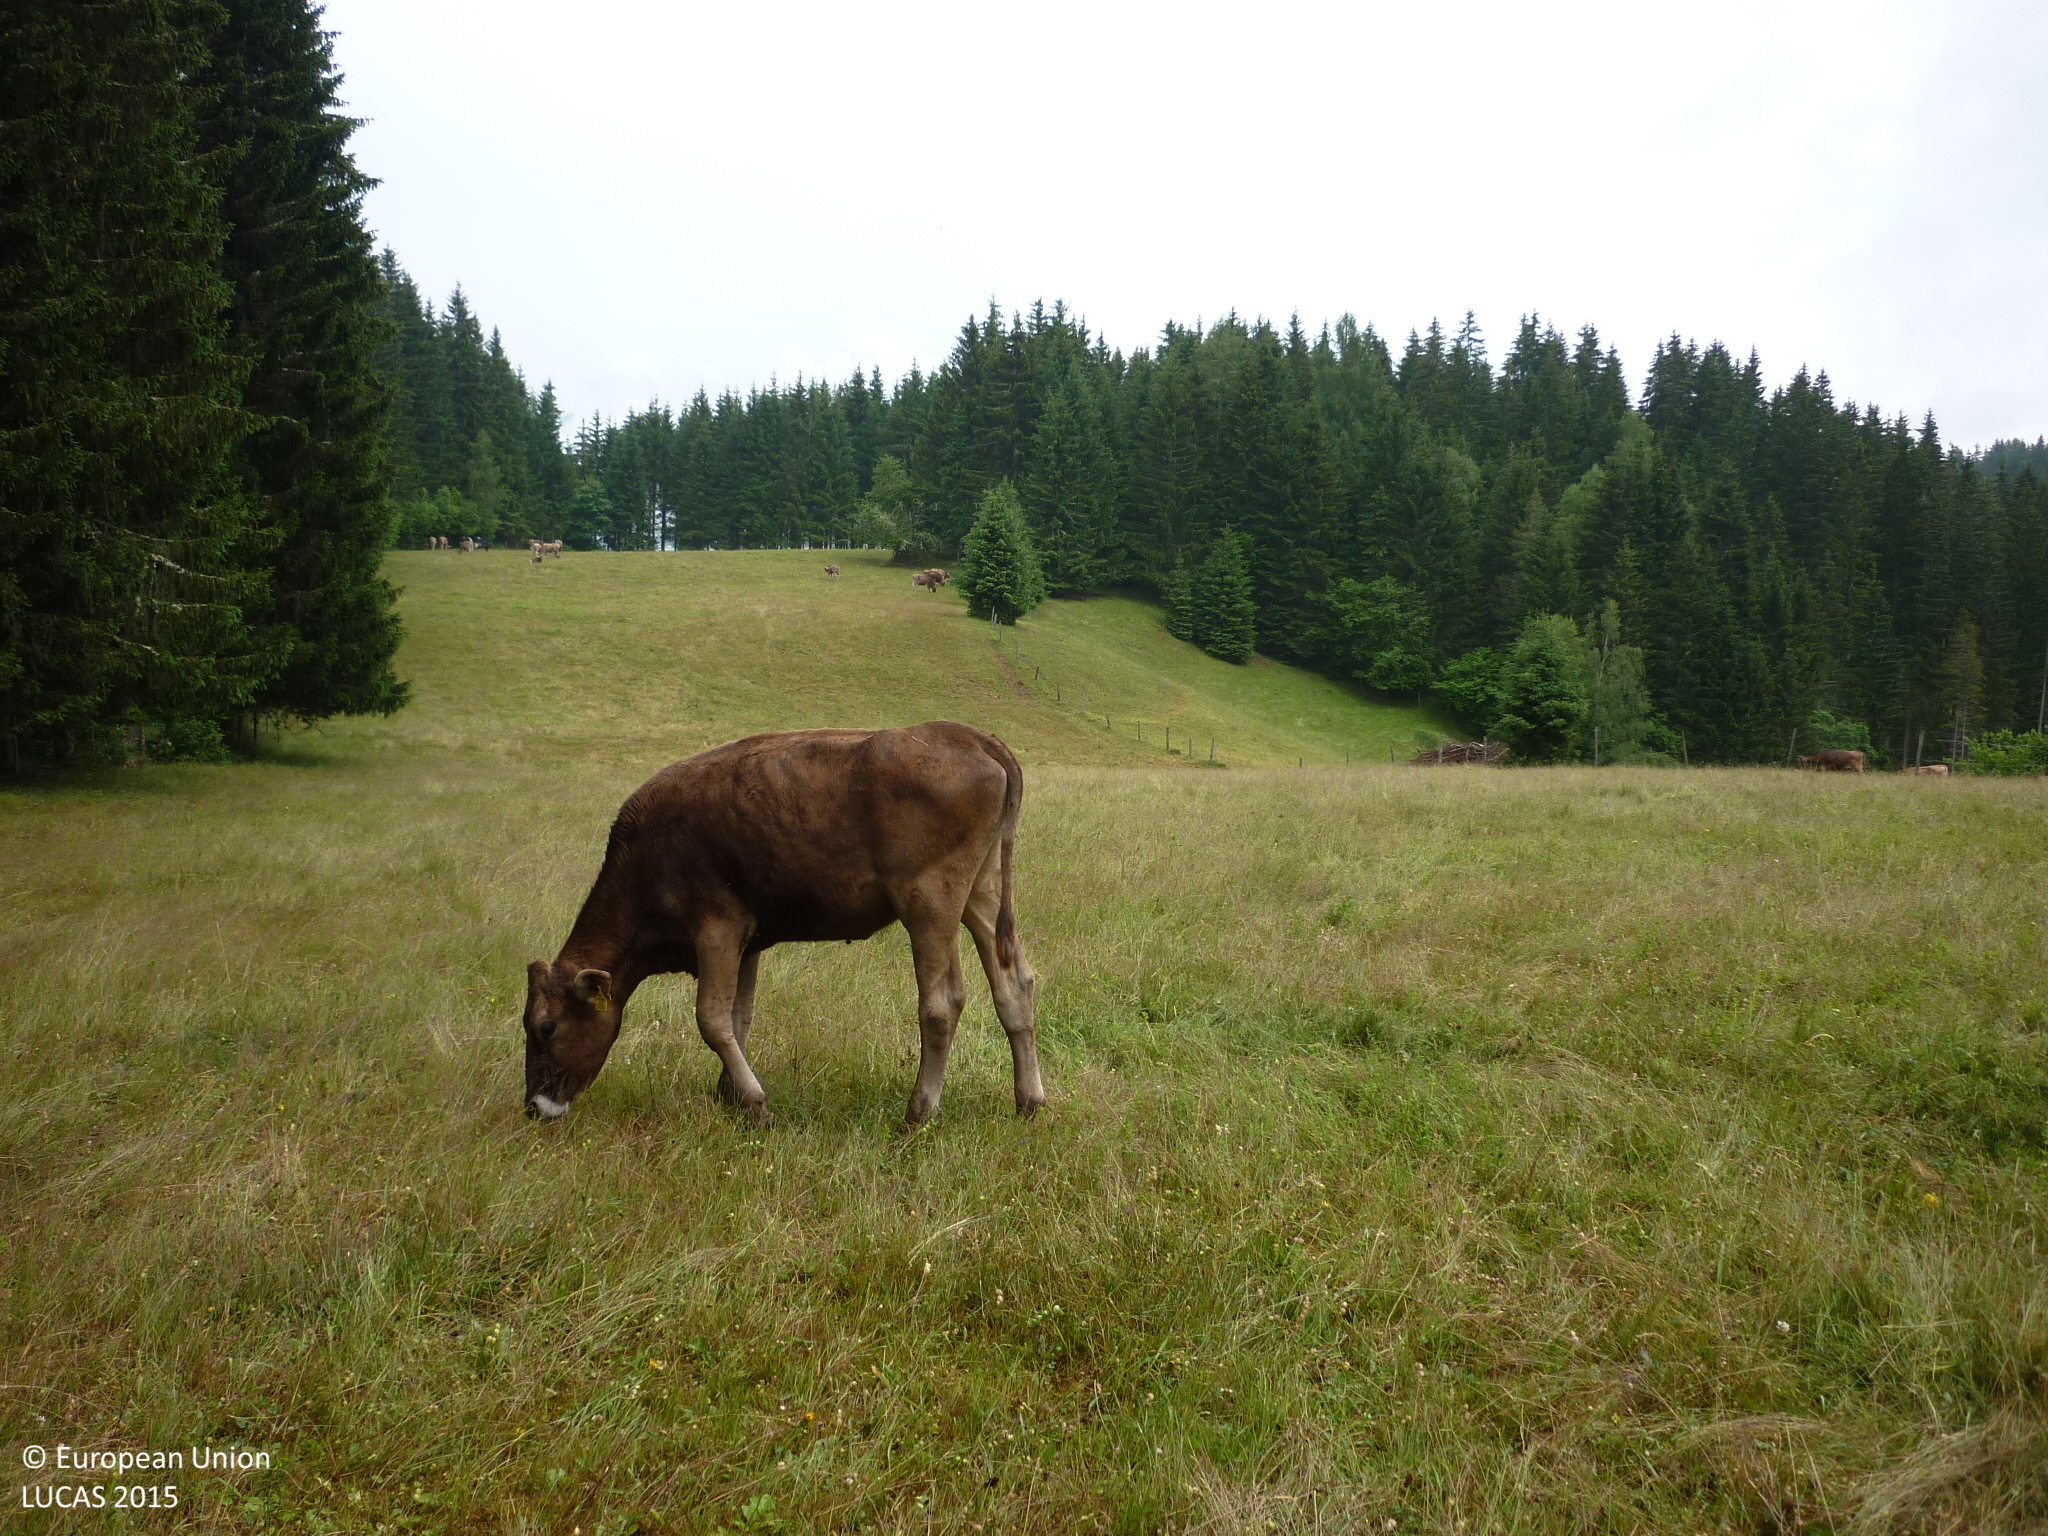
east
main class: Grassland
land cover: Grassland without tree/shrub cover
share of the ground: > 75 %
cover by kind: herbaceous plants 100 %
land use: Agriculture (excluding fallow land and kitchen gardens)
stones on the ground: < 10 %
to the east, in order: Grassland without tree/shrub cover; Fences; Spruce dominated coniferous woodland
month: June
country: AT
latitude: 47.0919
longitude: 14.3588
